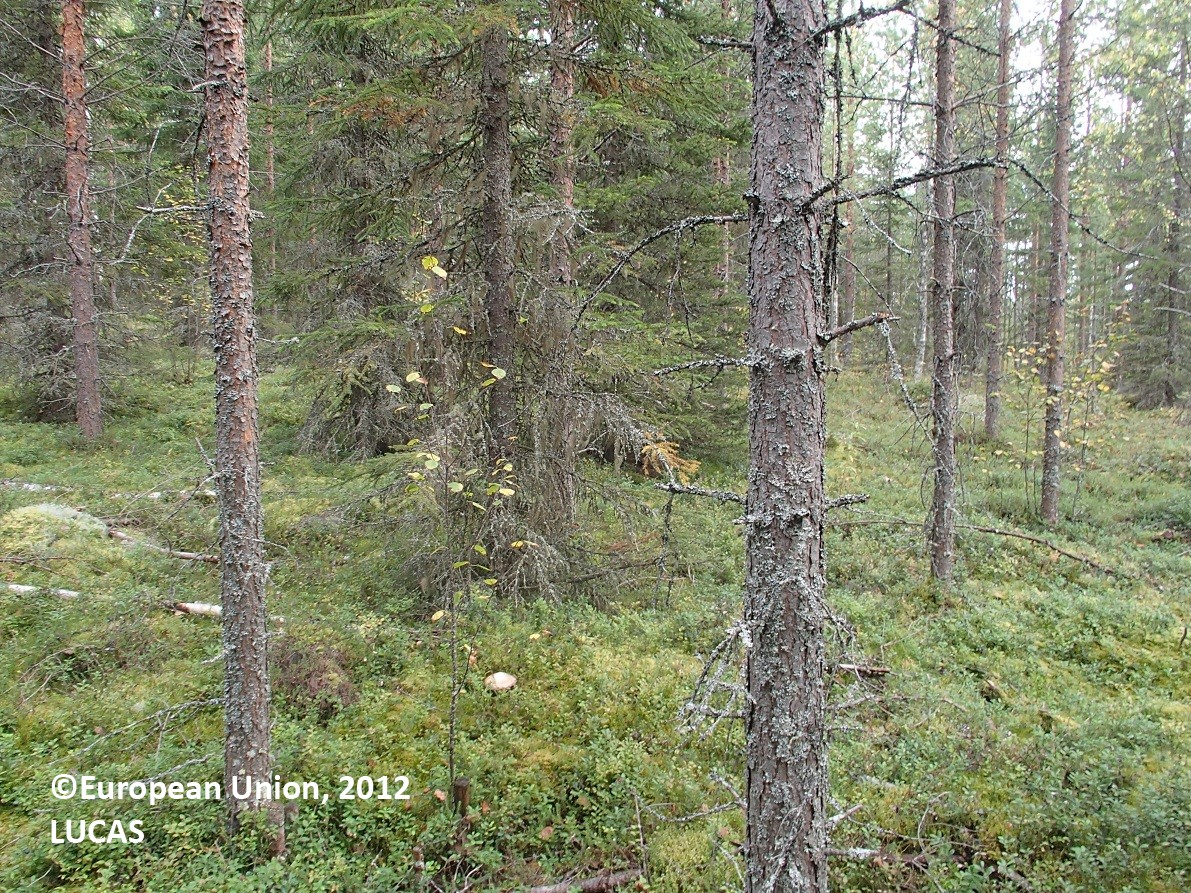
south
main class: Woodland
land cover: Other coniferous woodland
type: boreal forest
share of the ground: 50 - 75 %
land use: Forestry
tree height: > 5 m
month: August
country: FI
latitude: 63.7463
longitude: 26.6832
